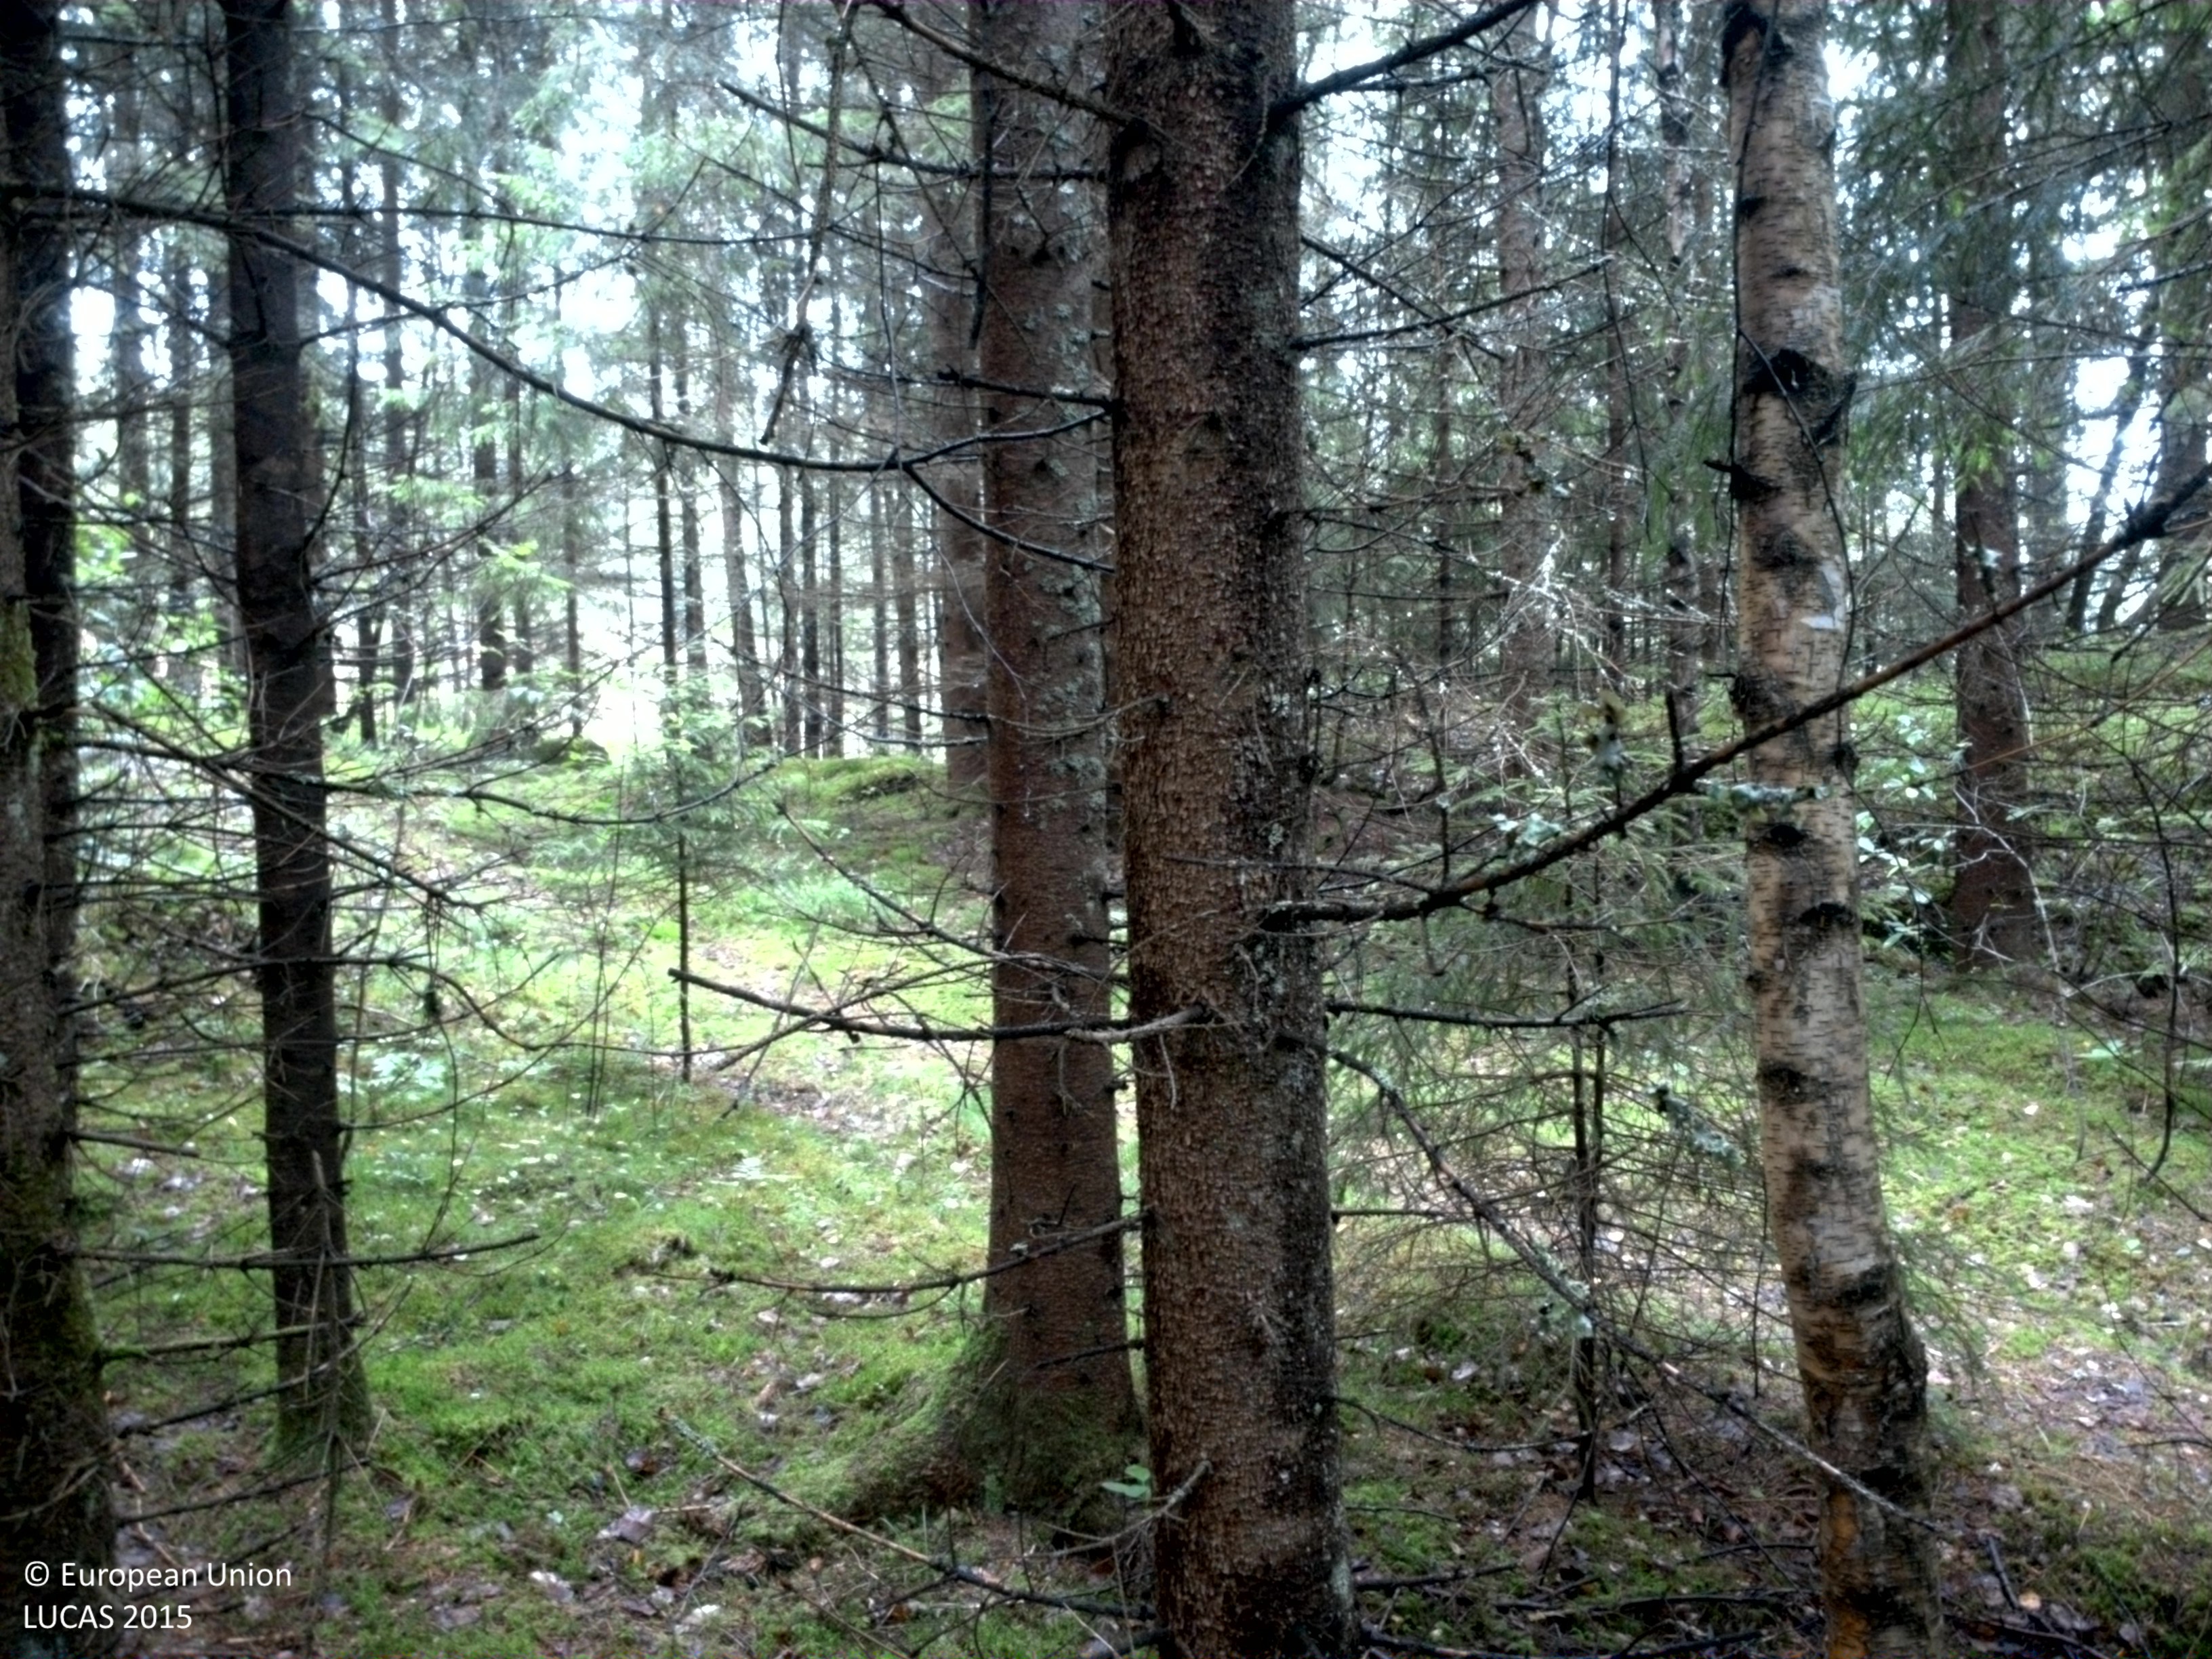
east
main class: Woodland
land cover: Spruce dominated coniferous woodland
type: boreal forest
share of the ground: 50 - 75 %
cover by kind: coniferous forest trees 70 %, lichens and mosses 20 %, broadleaved forest trees 5 %, herbaceous plants 5 %
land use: Forestry
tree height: > 5 m
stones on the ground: < 10 %
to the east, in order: Spruce dominated coniferous woodland; Tracks; Spruce dominated coniferous woodland; Shrubland with sparse tree cover; Rivers and streams; Shrubland with sparse tree cover; Pine dominated mixed woodland; Shrubland with sparse tree cover; Pine dominated mixed woodland
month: August
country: SE
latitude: 59.5141
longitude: 13.1909
